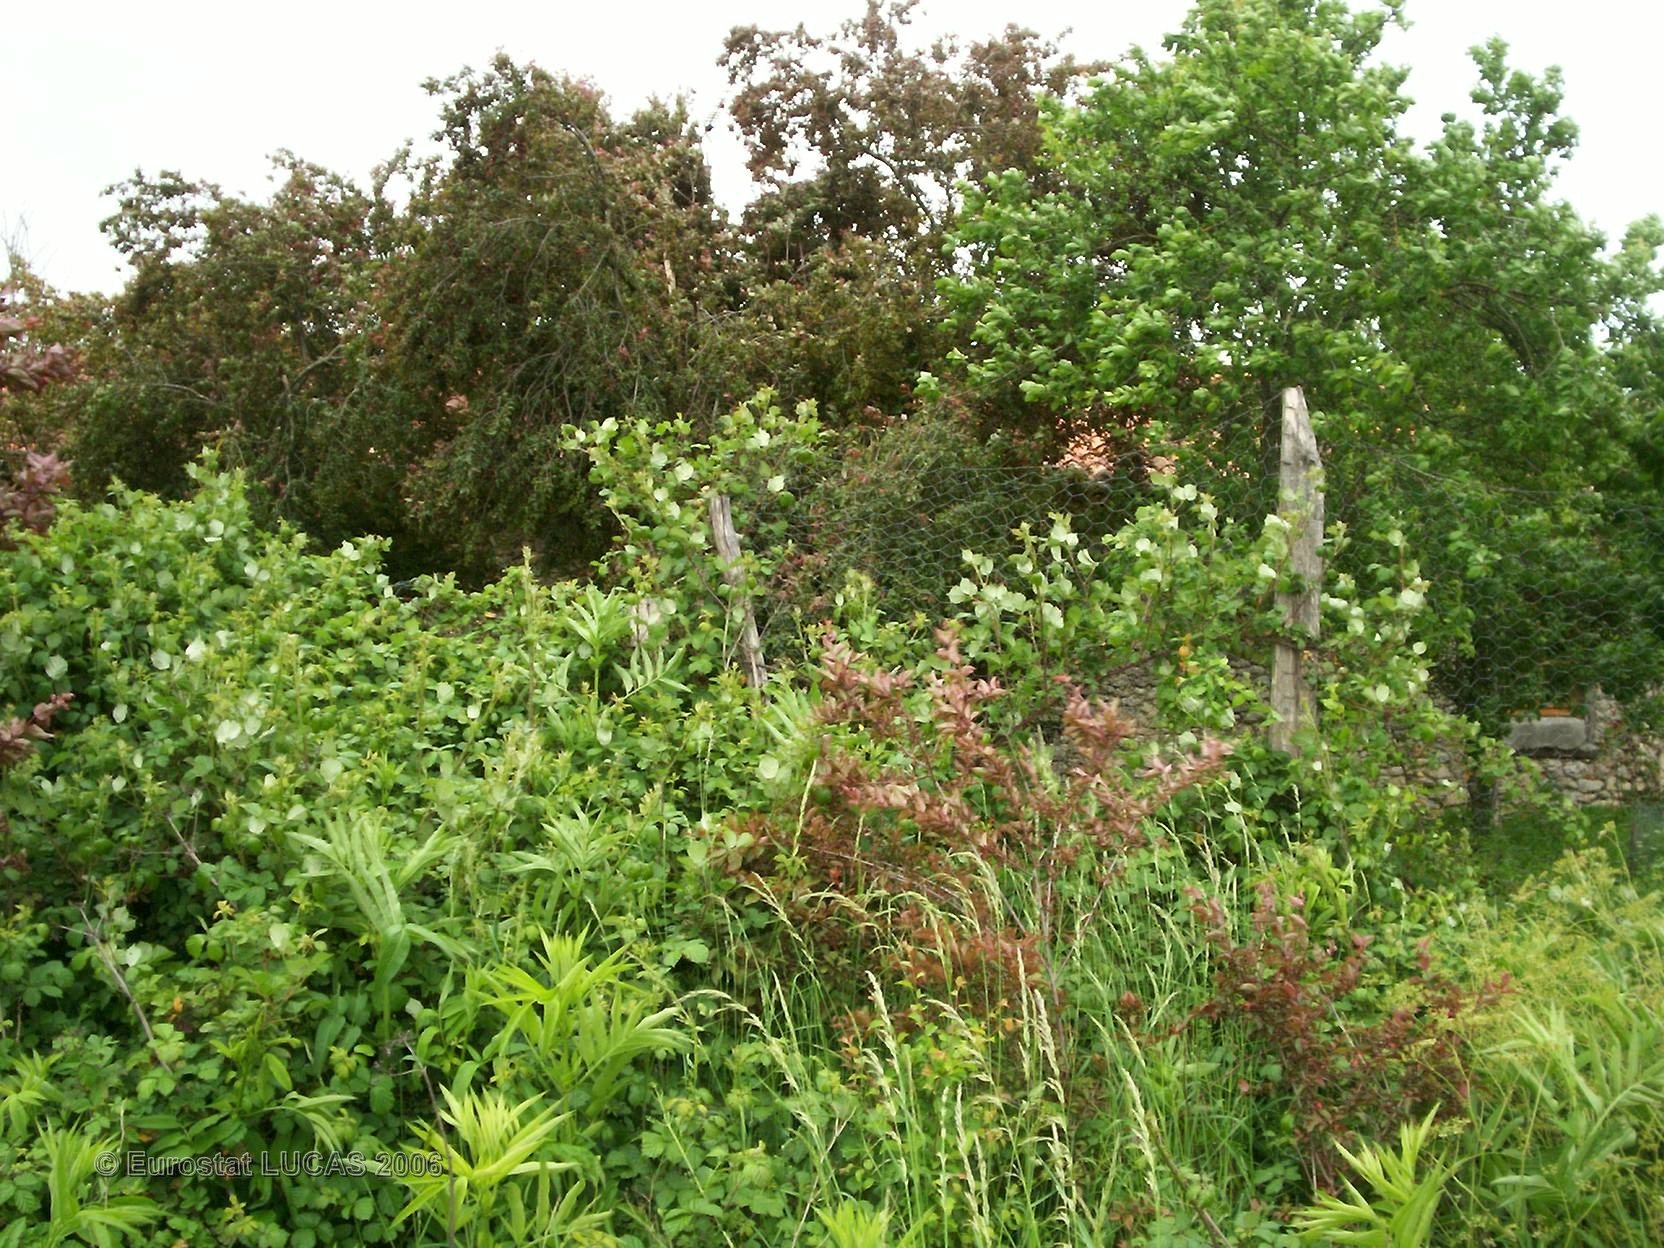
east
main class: Grassland
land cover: Grassland without tree/shrub cover
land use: Unused
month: May
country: FR
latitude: 45.3032
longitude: 0.6152
